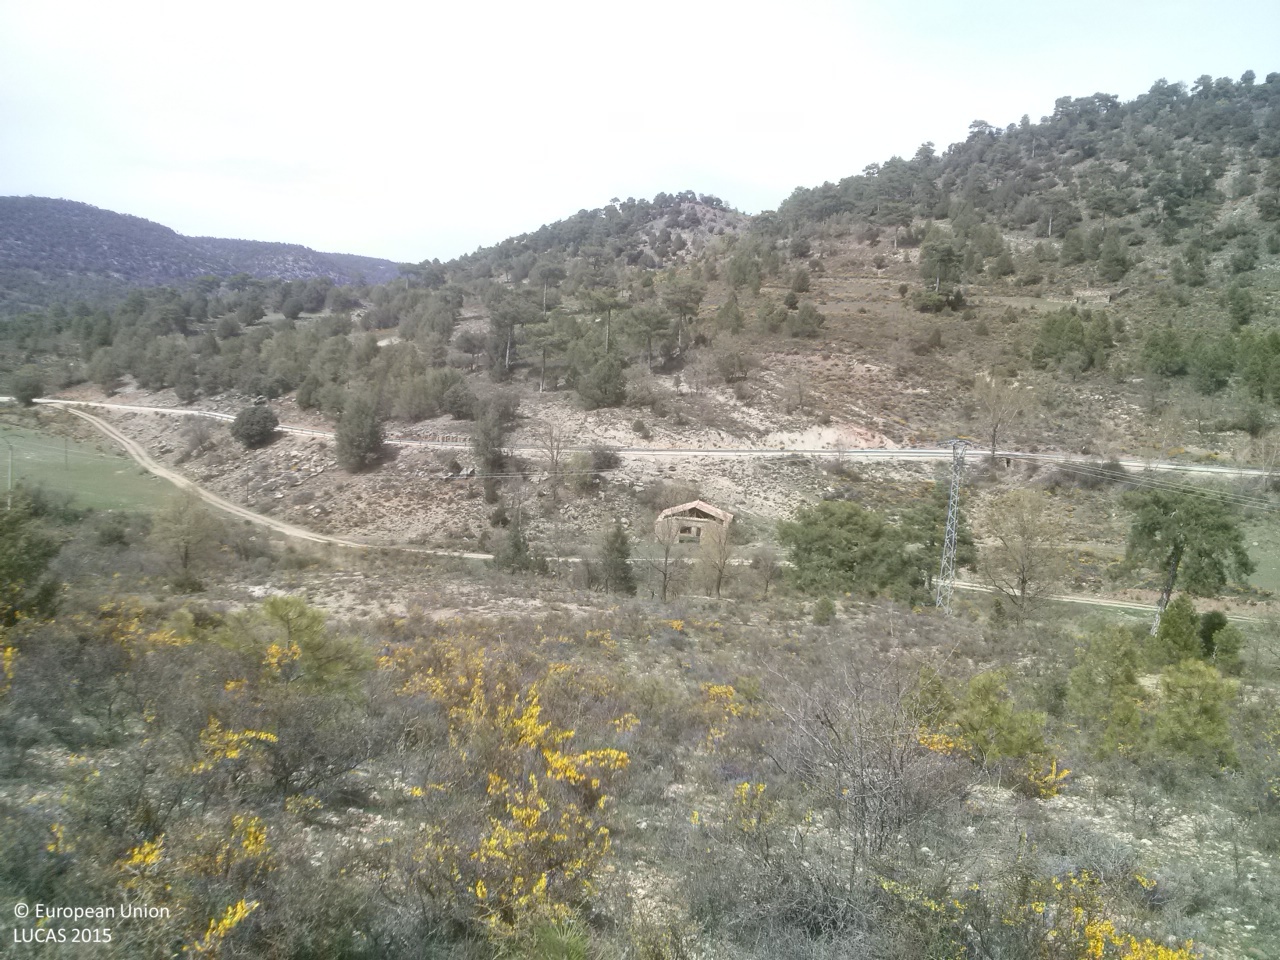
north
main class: Shrubland
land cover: Shrubland without tree cover
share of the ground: > 75 %
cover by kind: shrubs 80 %, herbaceous plants 20 %
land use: Agriculture (excluding fallow land and kitchen gardens)
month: April
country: ES
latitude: 40.0467
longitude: -1.7924
